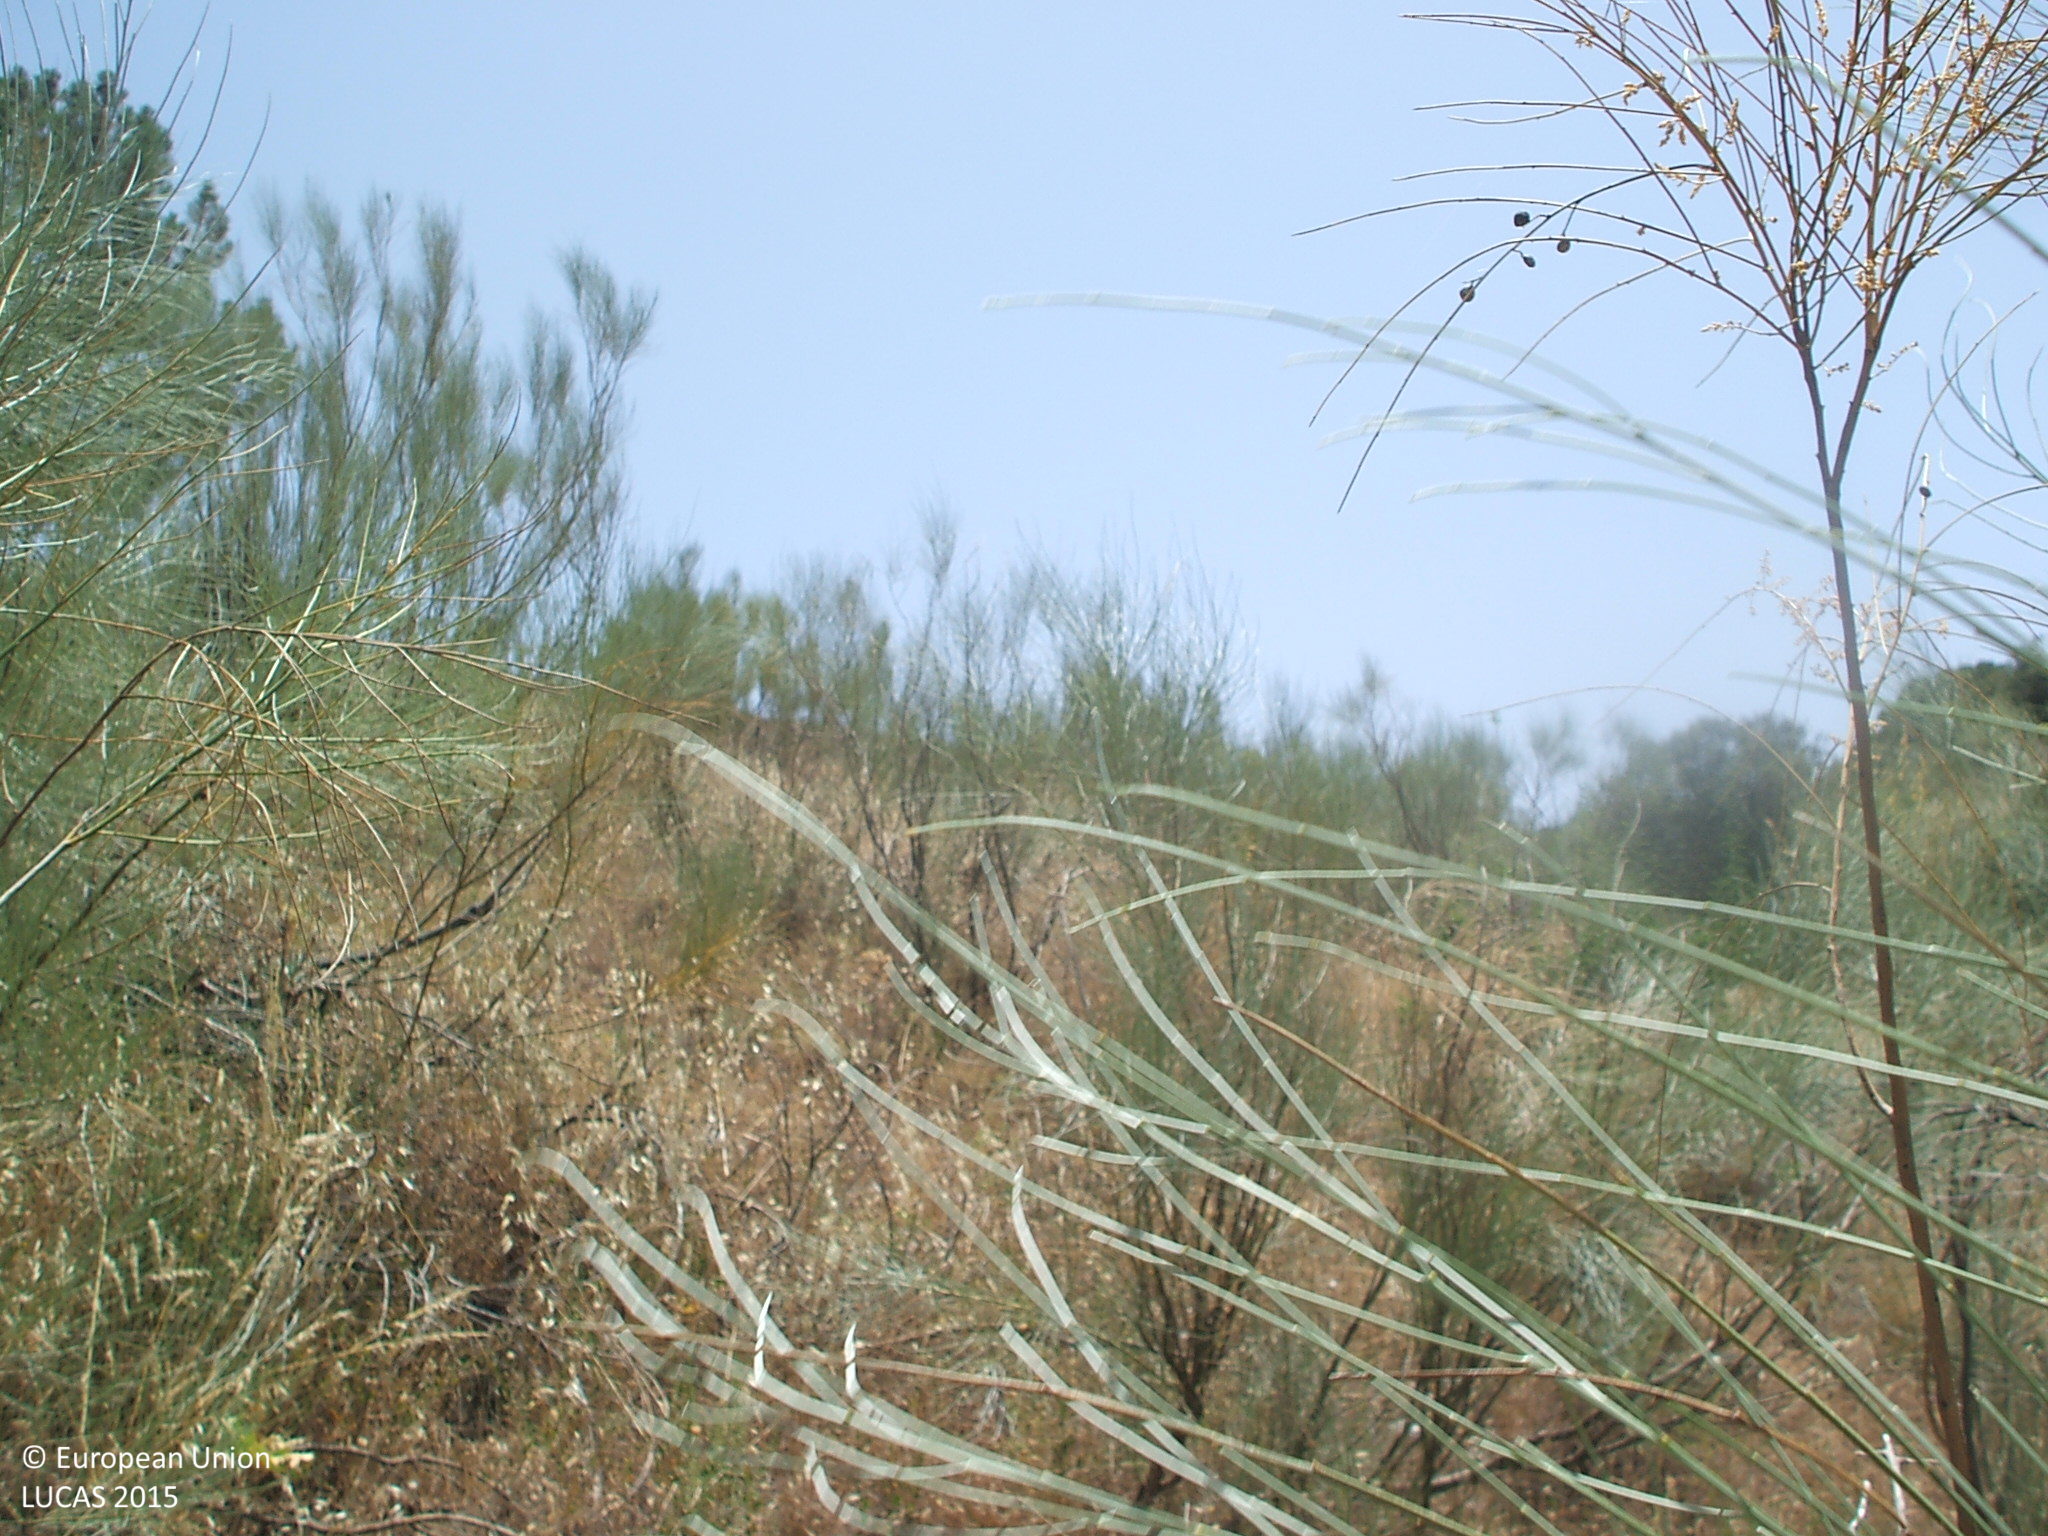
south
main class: Shrubland
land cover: Shrubland without tree cover
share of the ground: 50 - 75 %
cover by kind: shrubs 70 %, herbaceous plants 30 %
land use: Semi-natural and natural areas not in use
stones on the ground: > 50 %
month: July
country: ES
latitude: 37.2539
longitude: -2.3262
